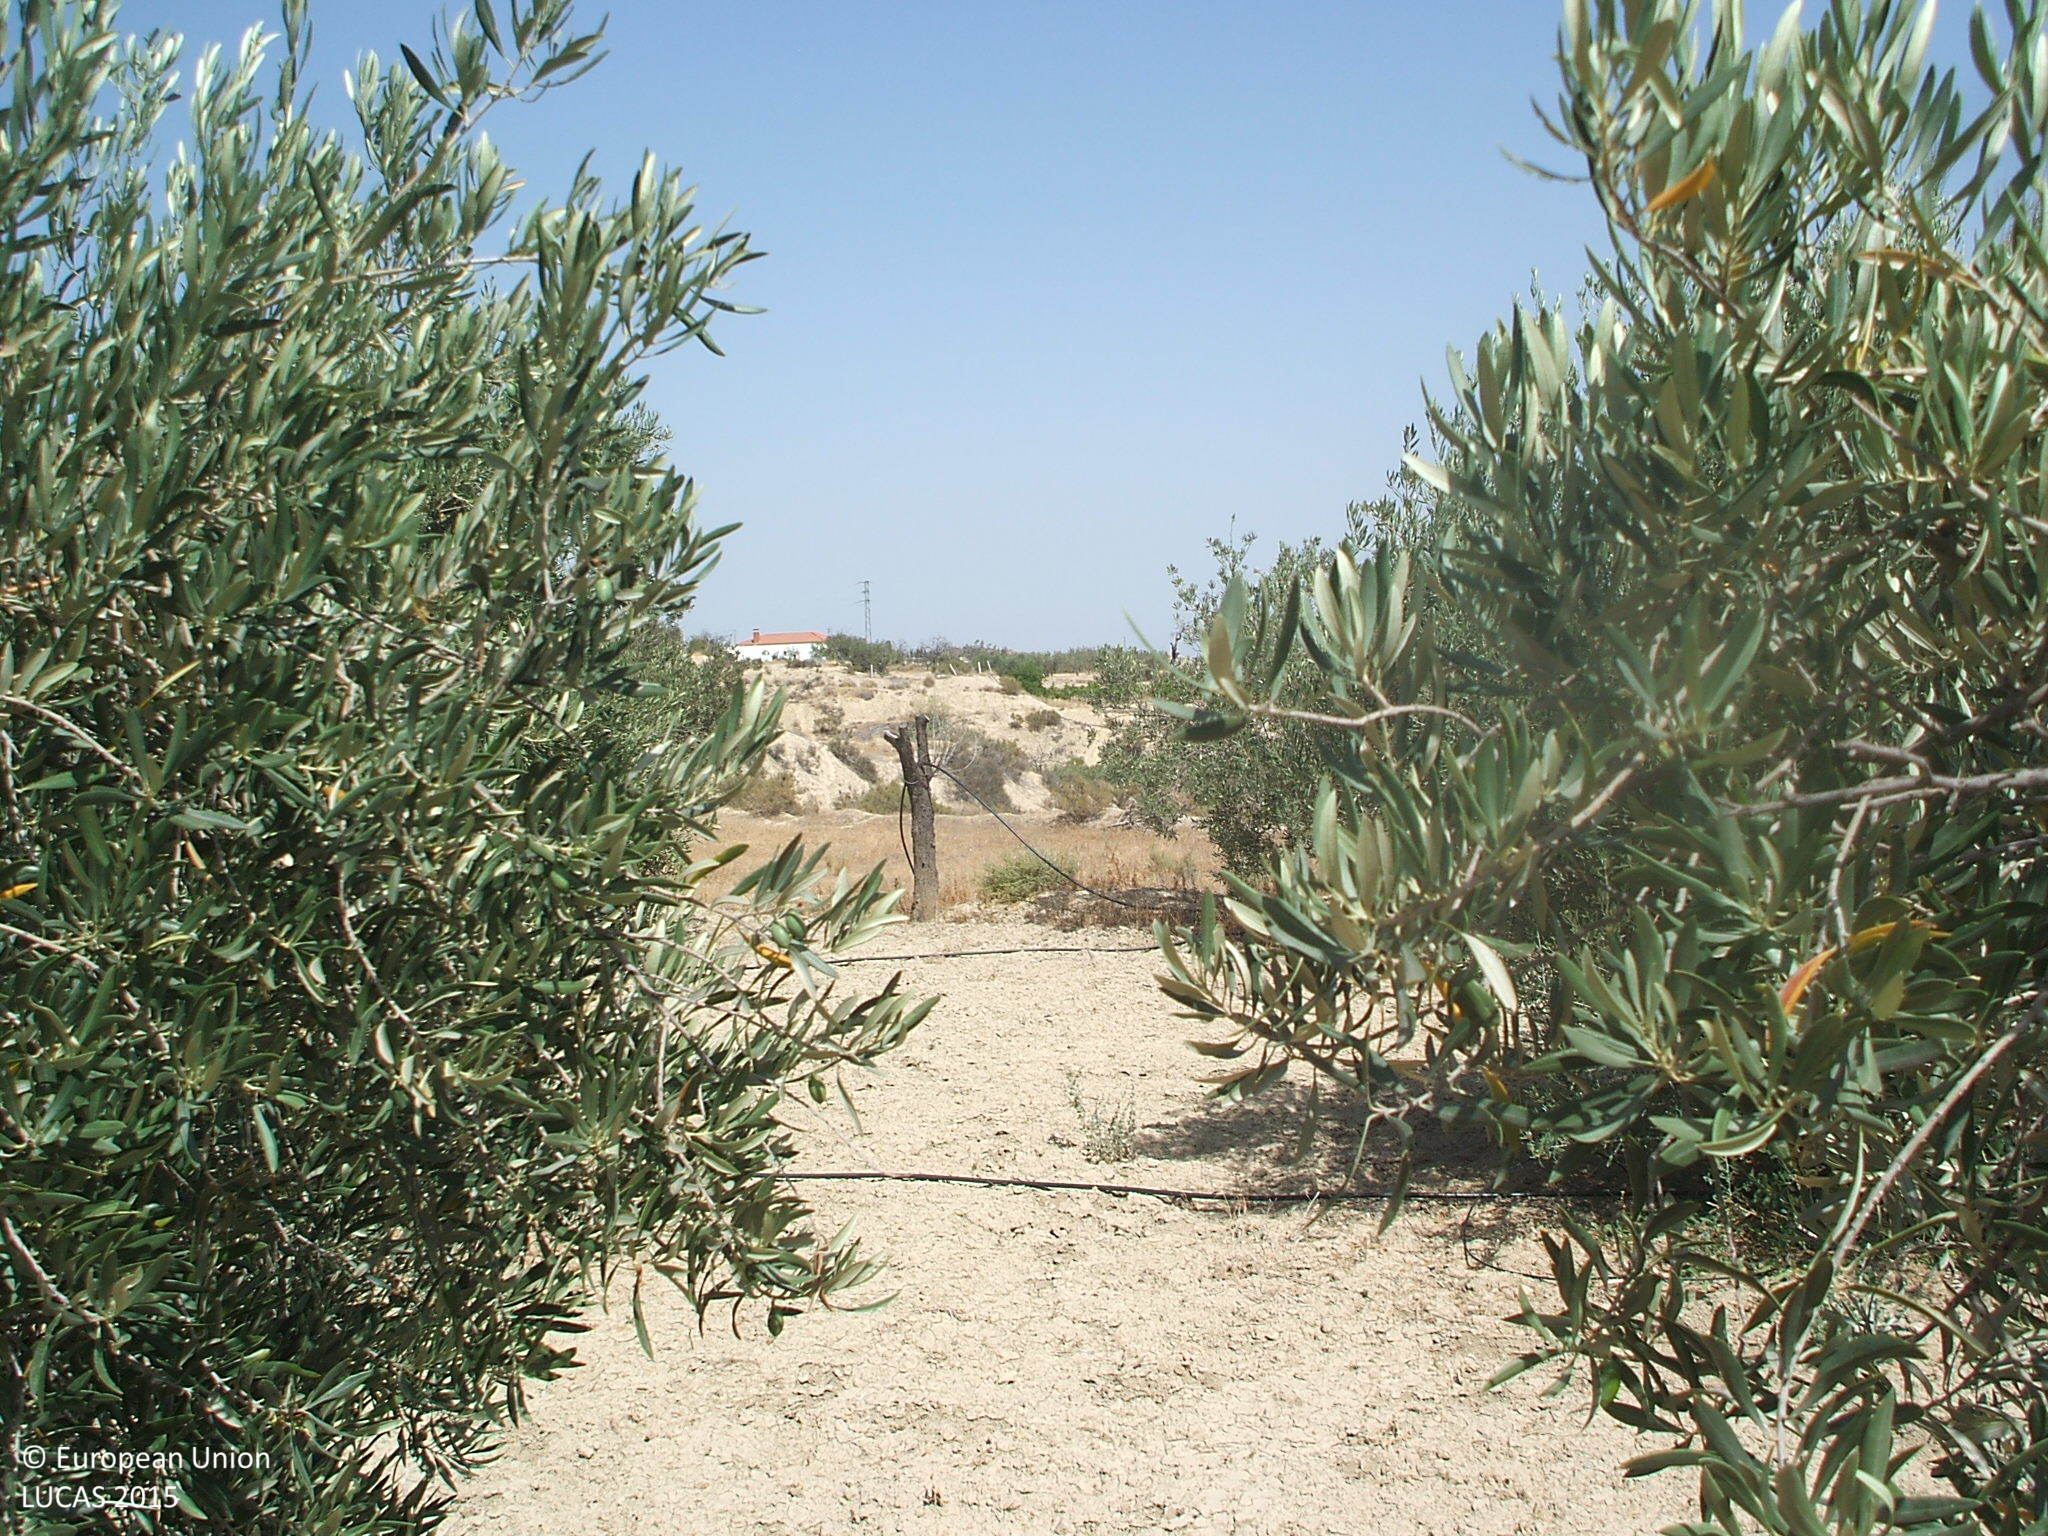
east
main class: Cropland
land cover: Olive groves
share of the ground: 50 - 75 %
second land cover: Other bare soil
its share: > 75 %
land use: Agriculture (excluding fallow land and kitchen gardens)
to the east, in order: Olive groves; Other bare soil; Shruby margins; Grassland without tree/shrub cover; Shrubland without tree cover; Rivers and streams; Shrubland without tree cover; Tracks; Olive groves; Grassland without tree/shrub cover; Olive groves; Grassland without tree/shrub cover; Olive groves; Shrubland without tree cover; Olive groves; Shrubland with sparse tree cover; Olive groves; Shrubland with sparse tree cover; Olive groves; Shrubland without tree cover; Olive groves; Shrubland with sparse tree cover
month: July
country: ES
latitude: 37.3821
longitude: -2.3264
